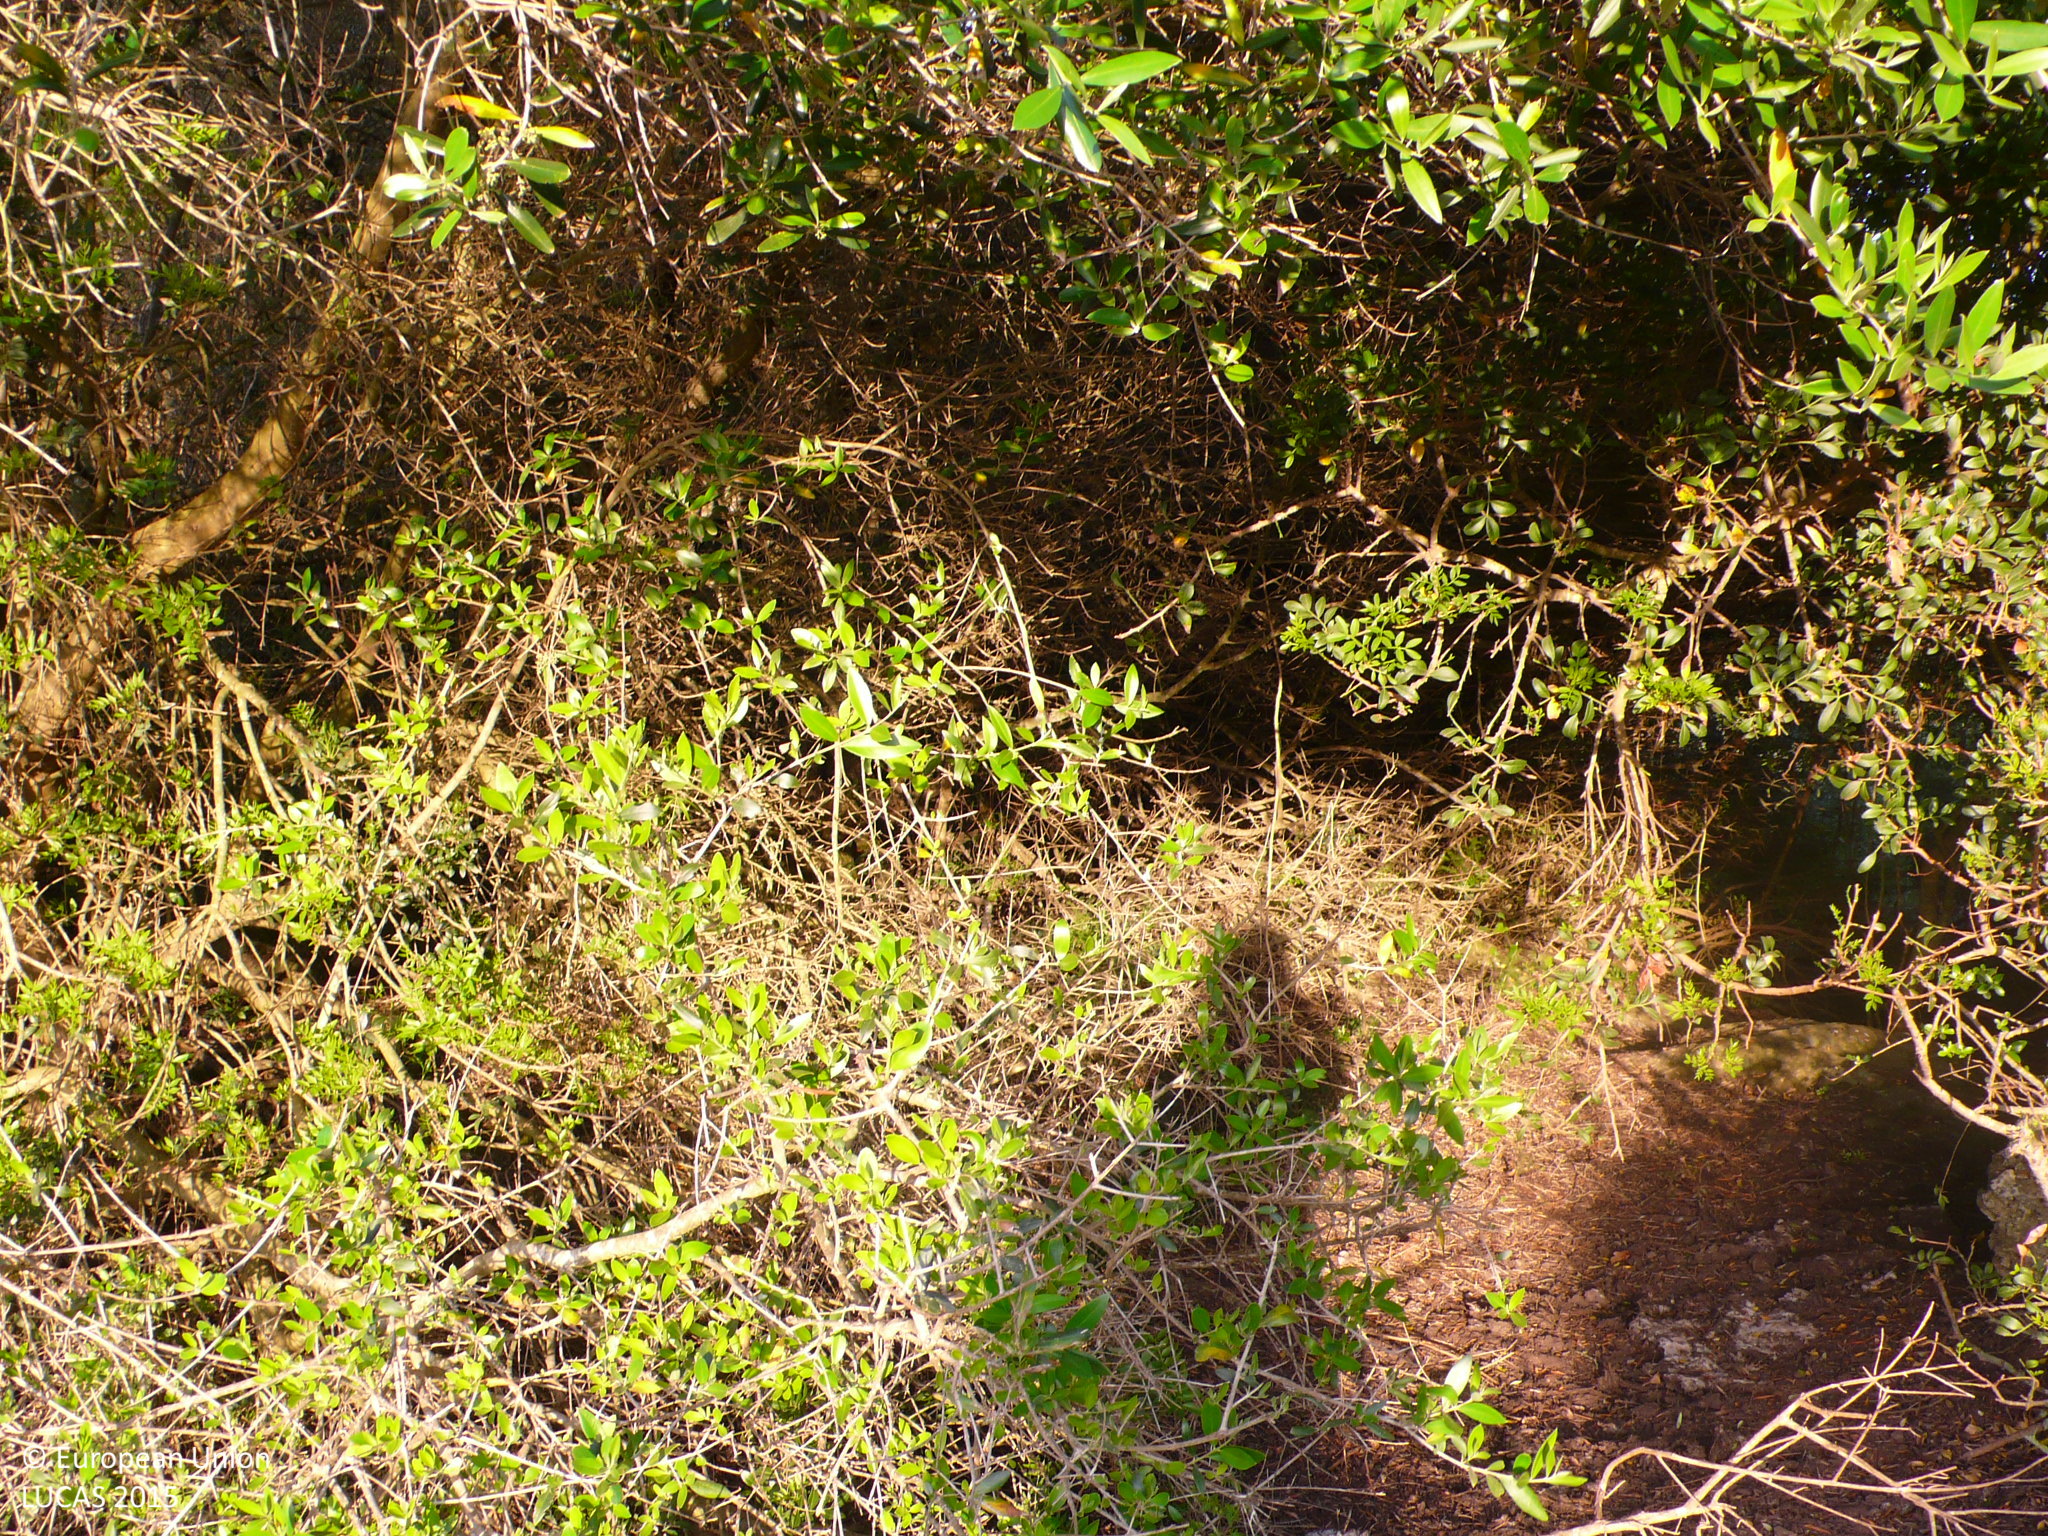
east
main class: Woodland
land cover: Broadleaved woodland
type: broadleaved evergreen forest
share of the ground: 50 - 75 %
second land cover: Grassland without tree/shrub cover
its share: > 75 %
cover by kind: broadleaved forest trees 60 %, shrubs 20 %, herbaceous plants 20 %
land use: Forestry
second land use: Agriculture (excluding fallow land and kitchen gardens)
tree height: > 5 m
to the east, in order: Broadleaved woodland; Grassland without tree/shrub cover; Electric lines; Broadleaved woodland; Grassland with sparse tree/shrub cover; Dry stone walls; Broadleaved woodland
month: May
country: ES
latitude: 39.9135
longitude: 4.1885
